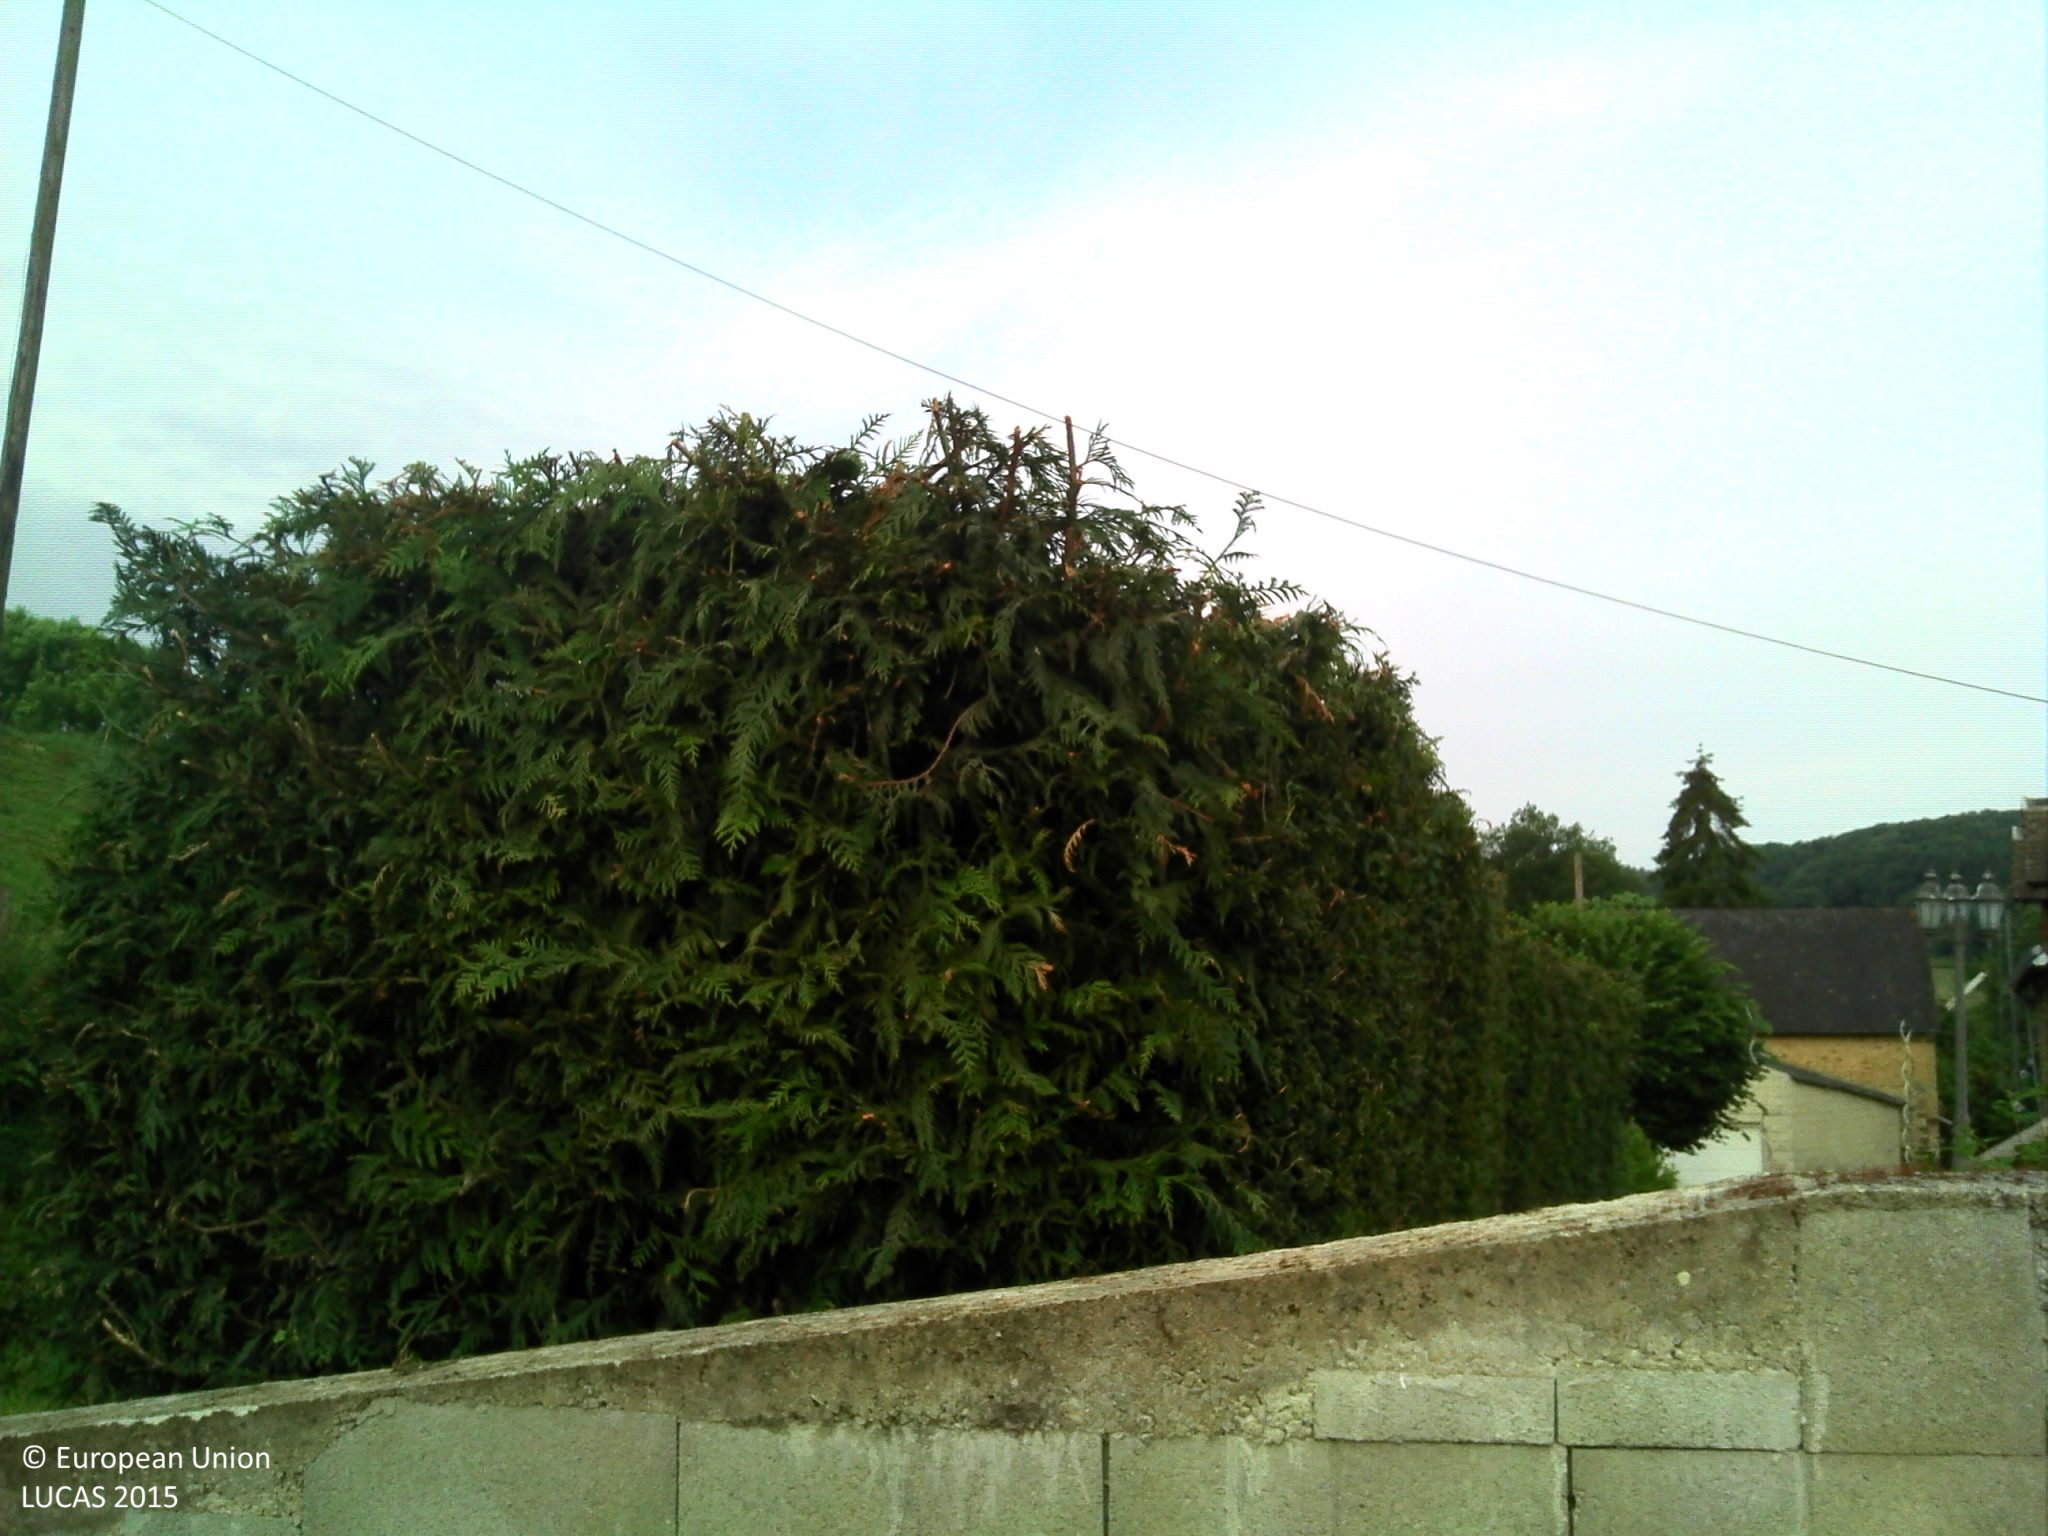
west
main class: Woodland
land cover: Broadleaved woodland
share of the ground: > 75 %
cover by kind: broadleaved forest trees 70 %, herbaceous plants 30 %
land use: Semi-natural and natural areas not in use
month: June
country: FR
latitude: 48.2515
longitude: -0.0631
